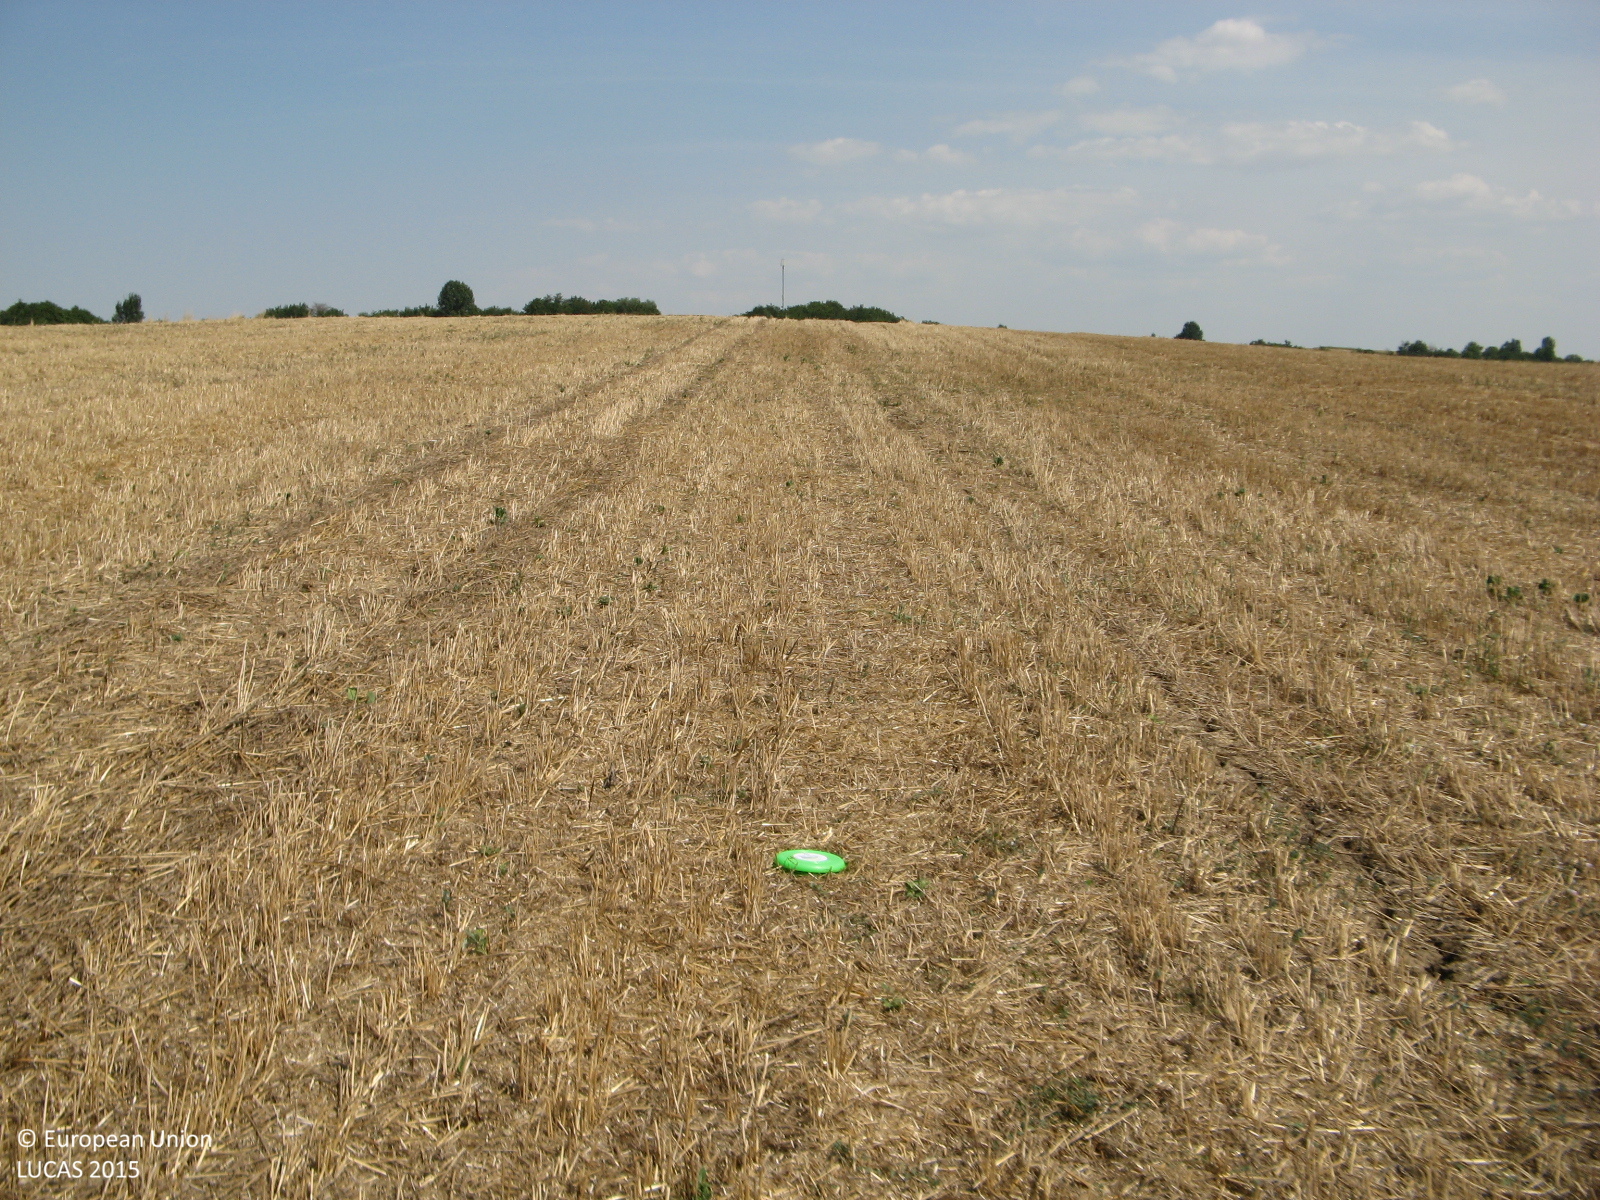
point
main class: Cropland
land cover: Common wheat
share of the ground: 50 - 75 %
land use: Agriculture (excluding fallow land and kitchen gardens)
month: August
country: BG
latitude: 43.3666
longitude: 25.3418
